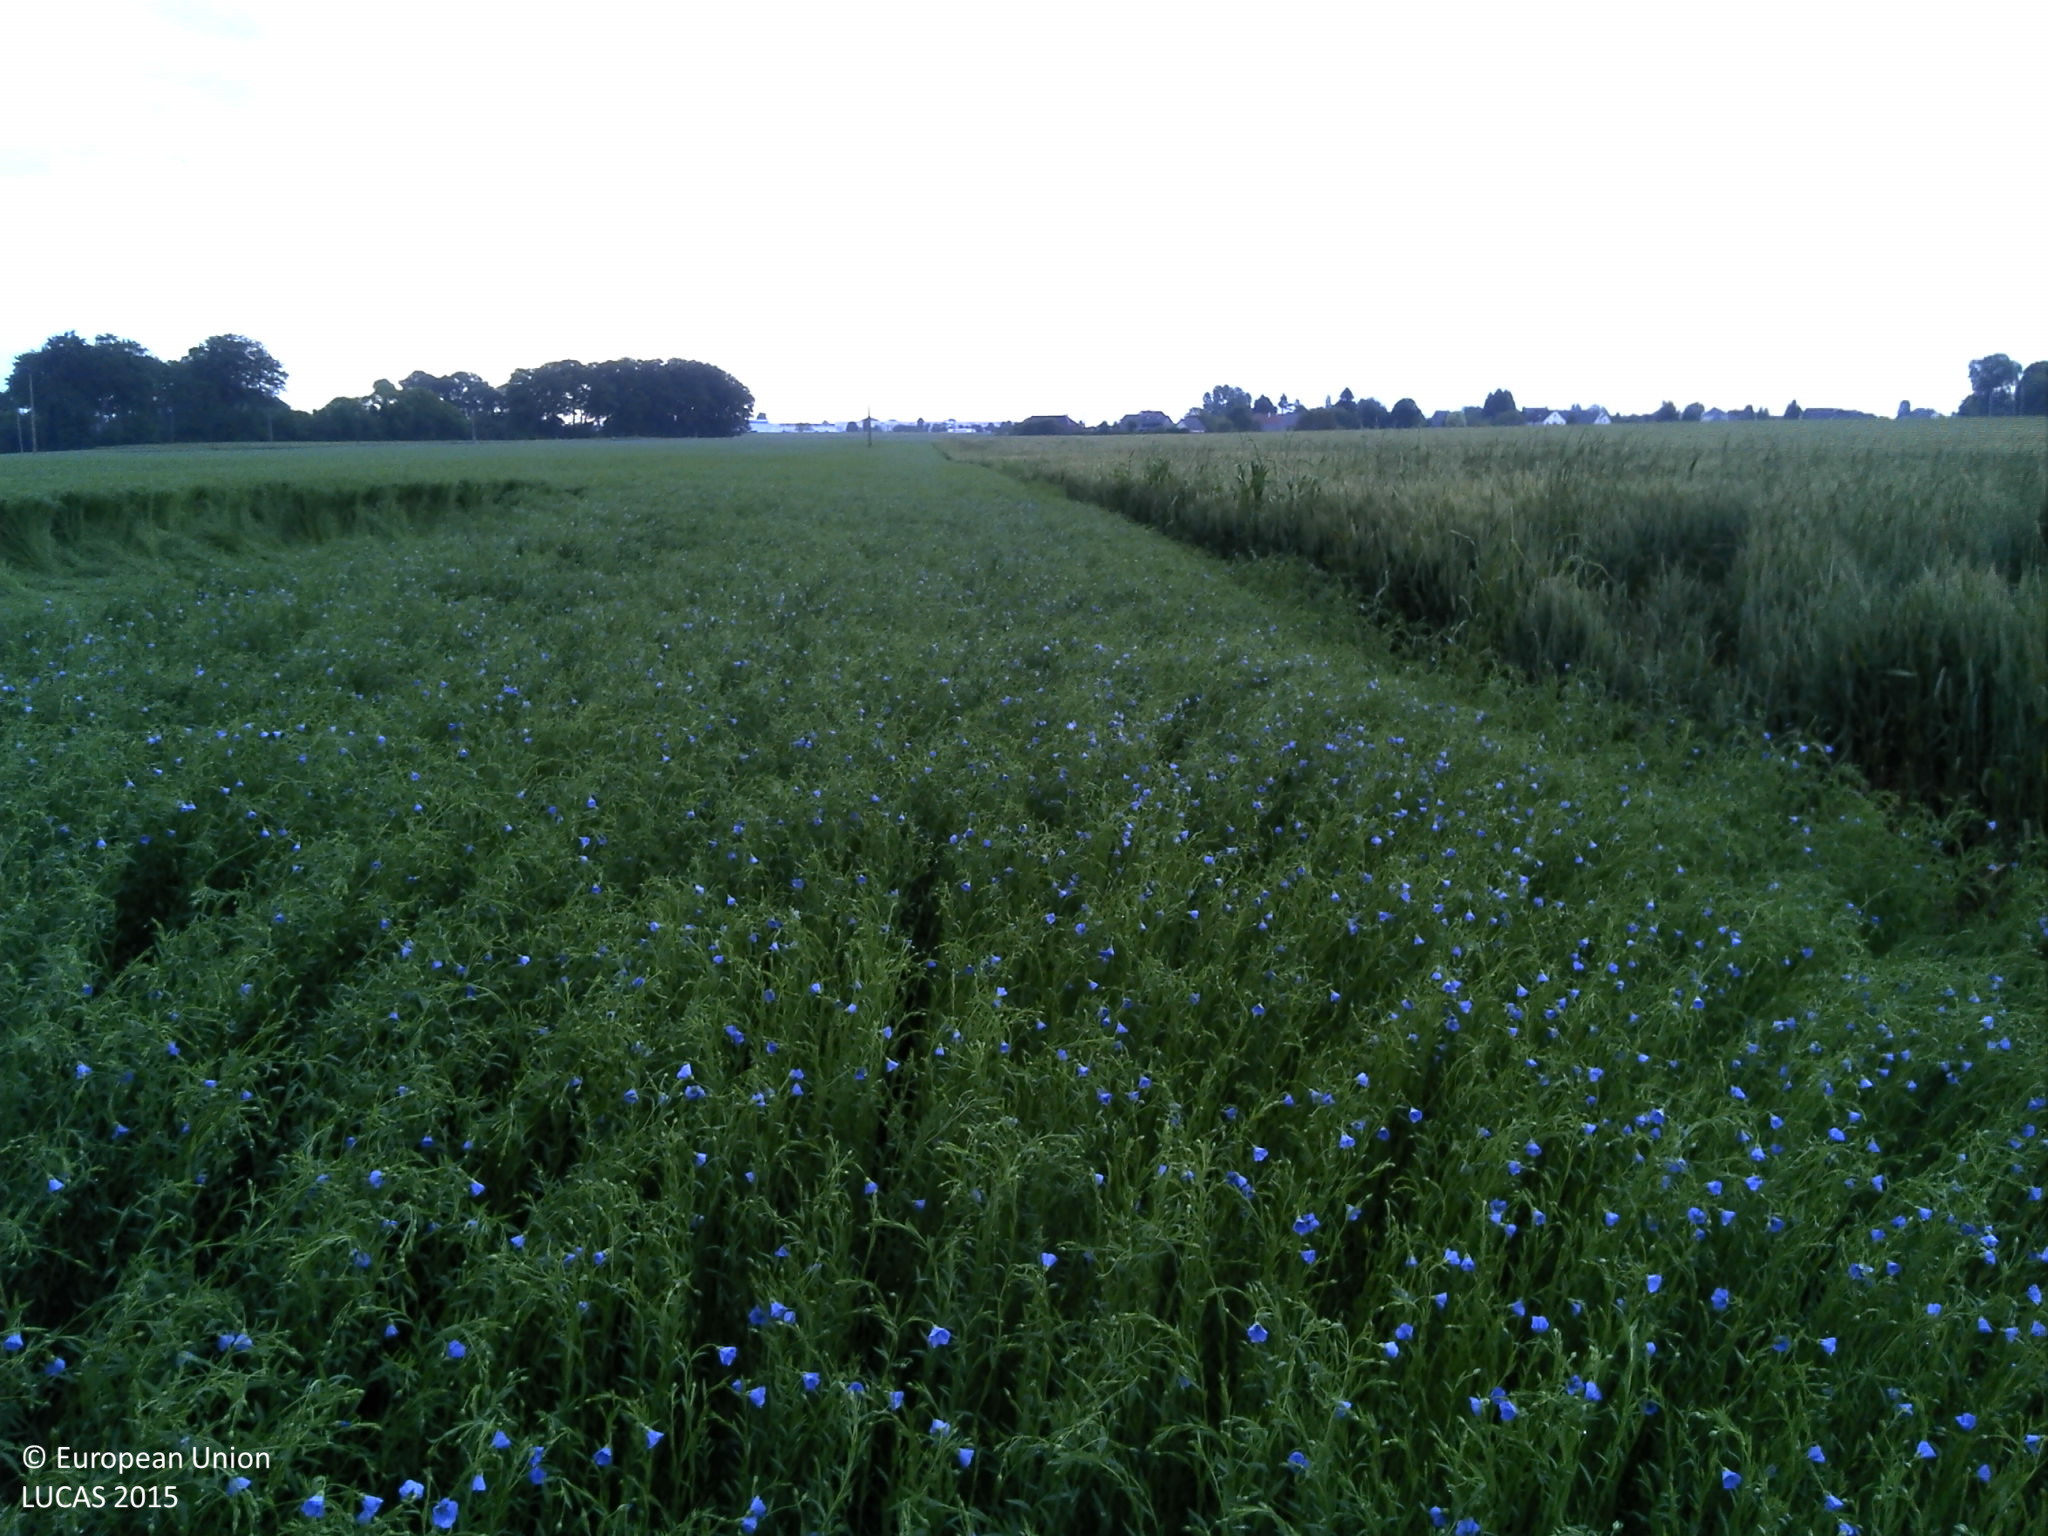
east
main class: Cropland
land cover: Other fibre and oleaginous crops
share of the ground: > 75 %
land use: Agriculture (excluding fallow land and kitchen gardens)
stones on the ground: < 10 %
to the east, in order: Other fibre and oleaginous crops; Electric lines; Other fibre and oleaginous crops
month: June
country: FR
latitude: 49.5377
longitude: 0.3402
